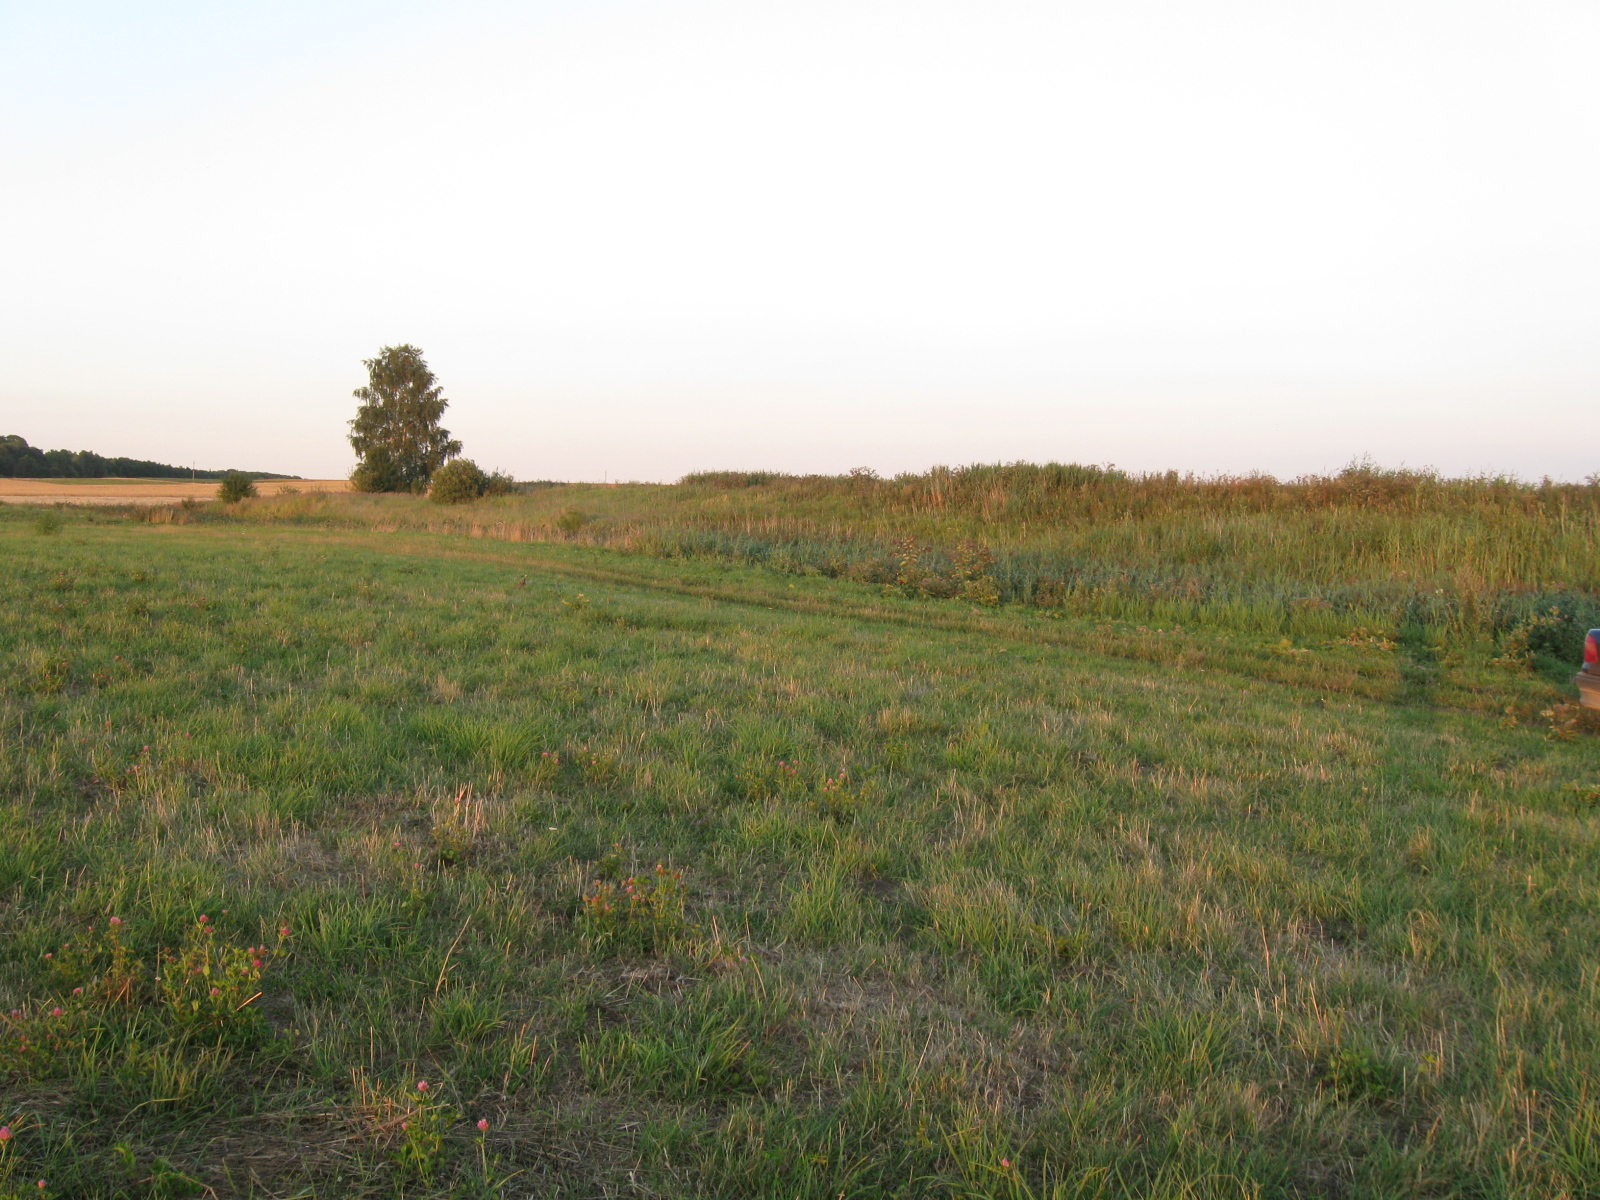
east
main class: Grassland
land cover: Grassland without tree/shrub cover
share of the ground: > 75 %
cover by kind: herbaceous plants 90 %, unconsolidated bare surface 10 %
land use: Agriculture (excluding fallow land and kitchen gardens)
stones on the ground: < 10 %
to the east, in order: Grassland without tree/shrub cover; Tracks; Grassland without tree/shrub cover; Spontaneously vegetated surfaces; Inland fresh running water; Spontaneously vegetated surfaces; Inland fresh running water; Spontaneously vegetated surfaces; Inland fresh running water; Spontaneously vegetated surfaces; Barley; Grassland without tree/shrub cover
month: July
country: LT
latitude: 54.4209
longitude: 23.4114
